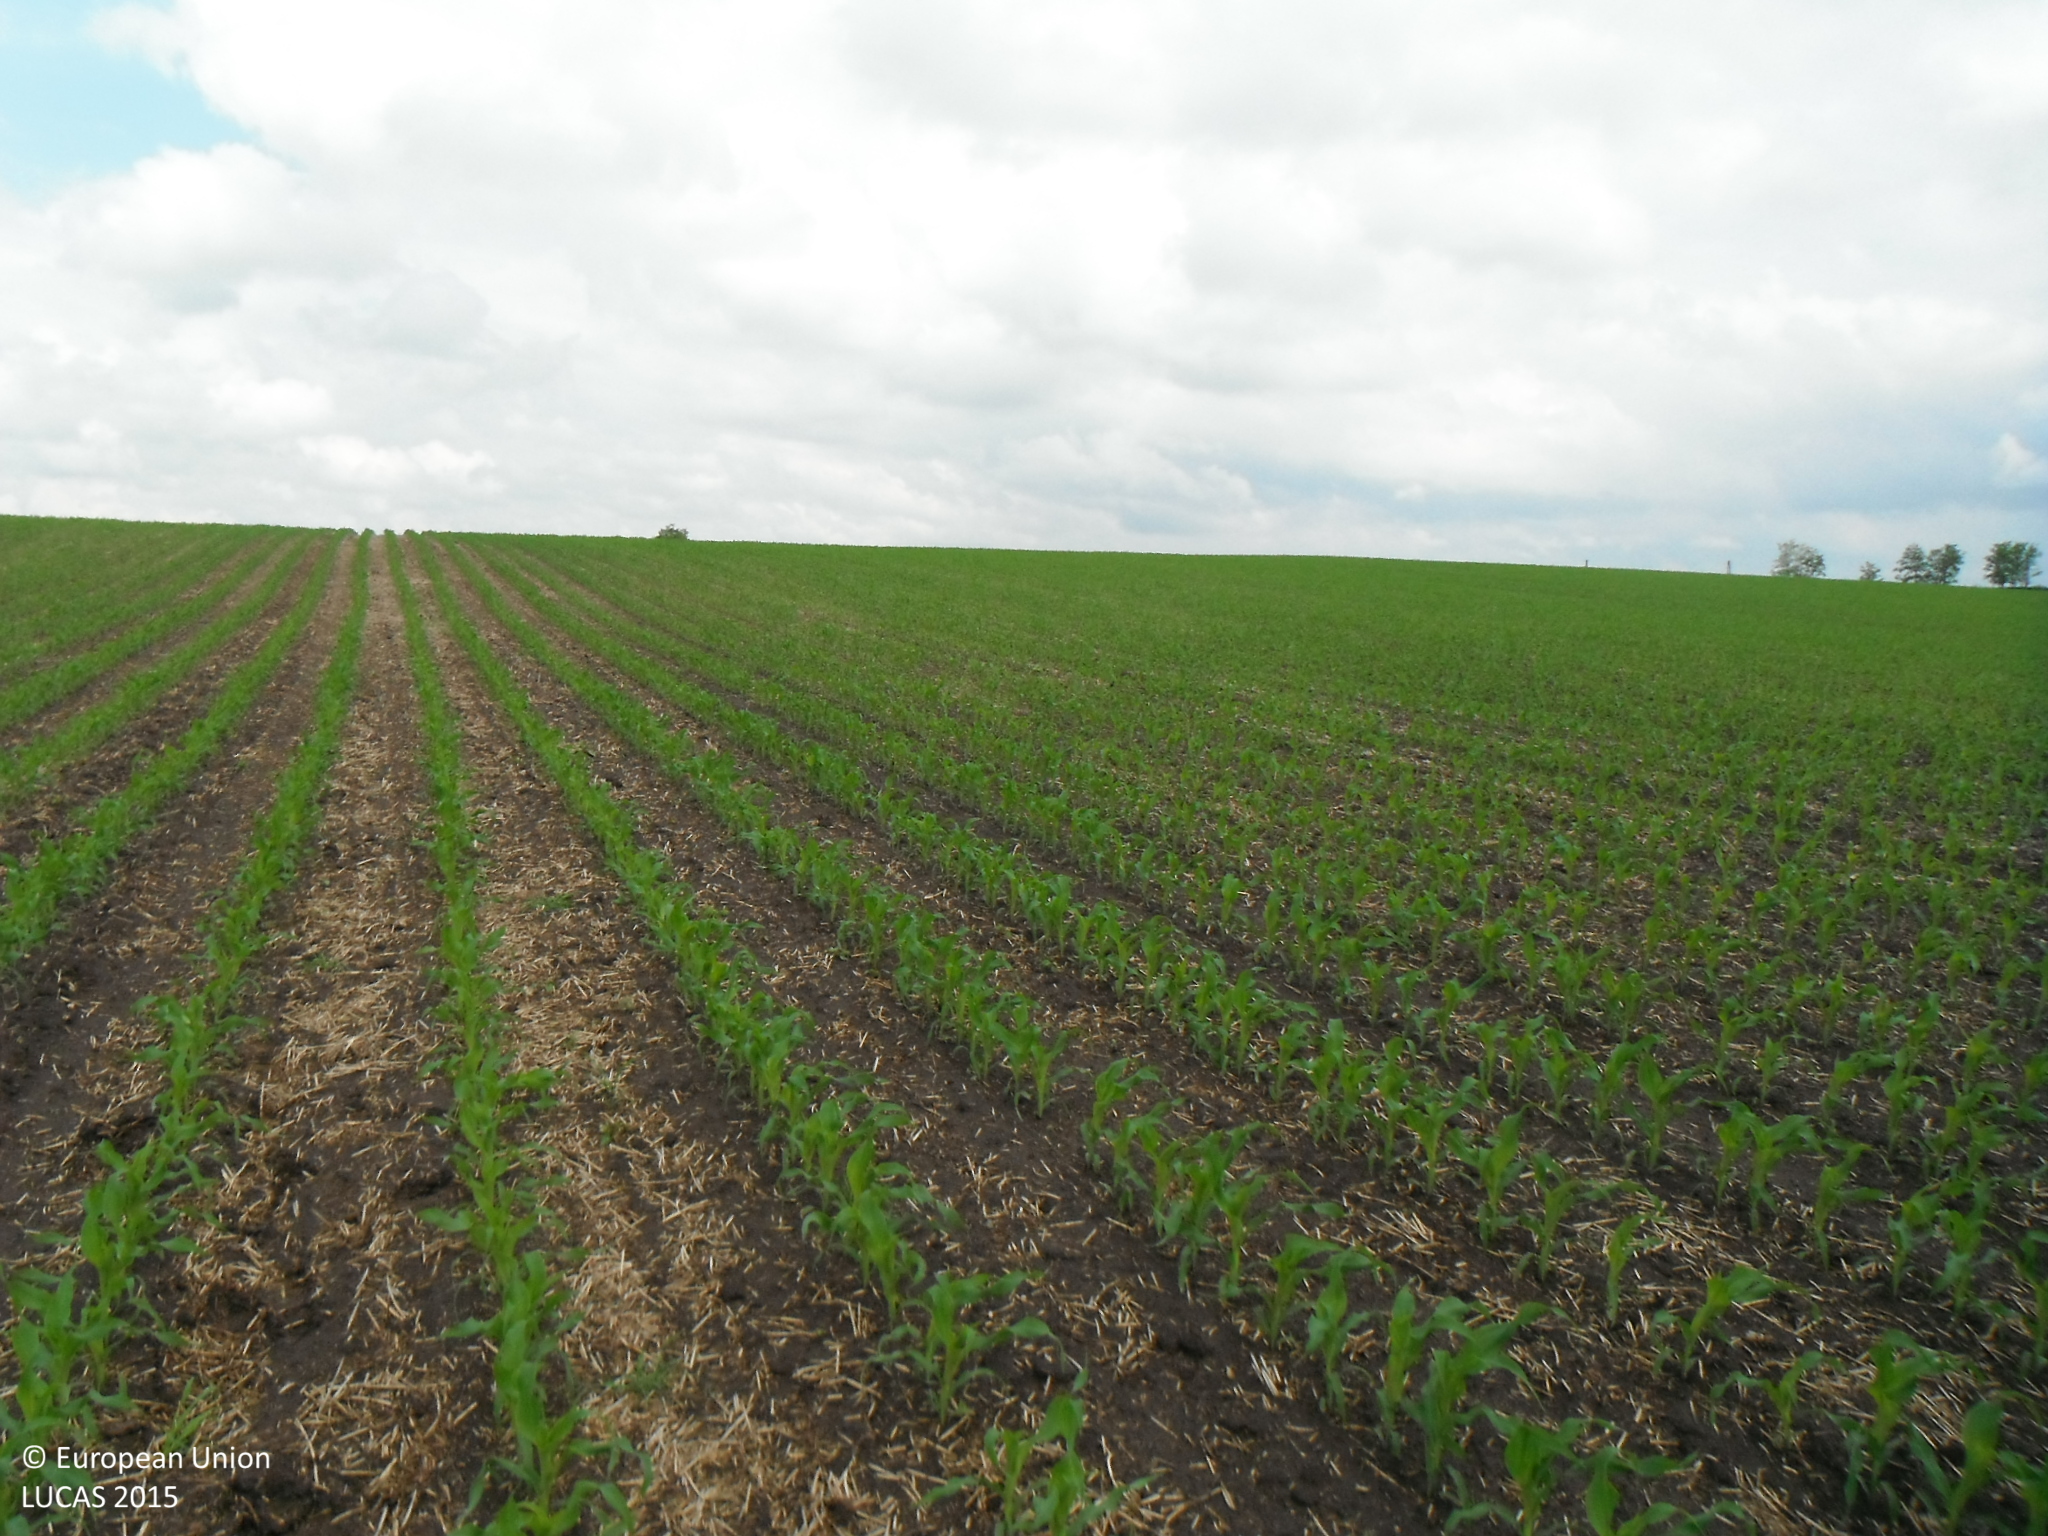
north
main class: Cropland
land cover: Maize
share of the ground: 25 - 50 %
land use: Agriculture (excluding fallow land and kitchen gardens)
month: May
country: SK
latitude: 48.1012
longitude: 18.1649
